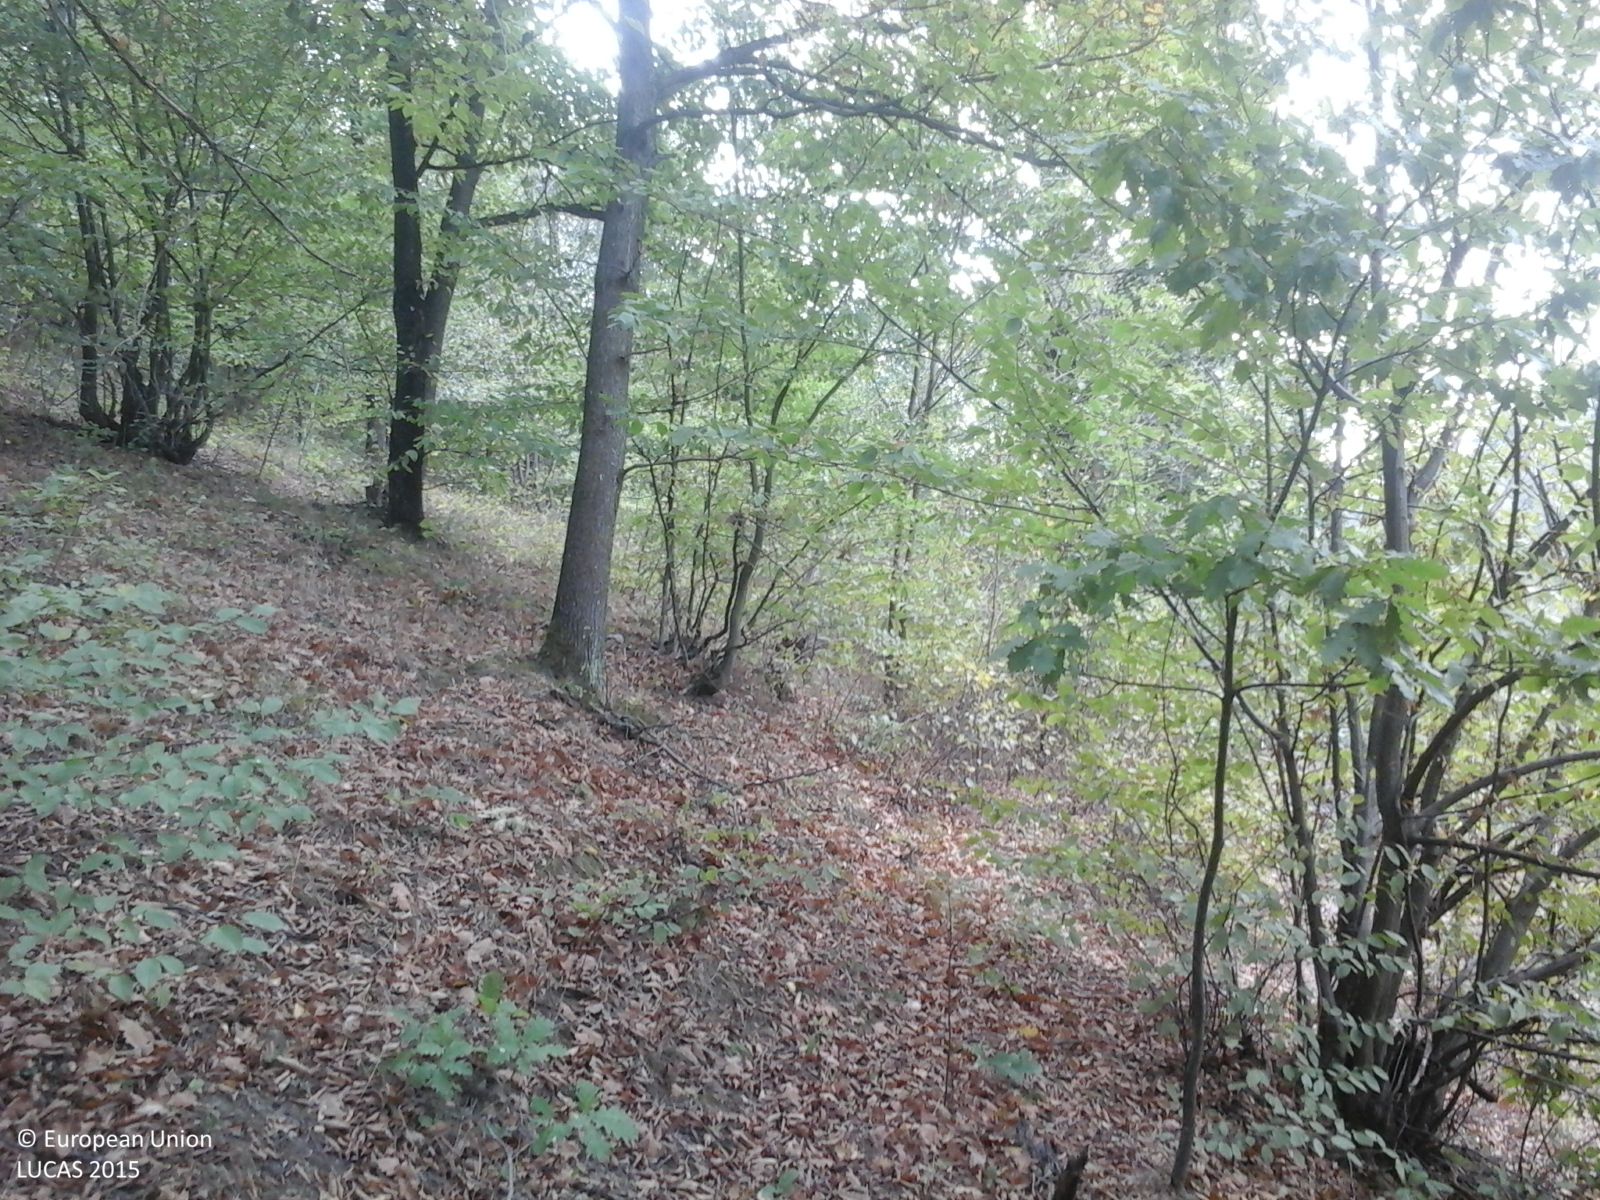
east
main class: Woodland
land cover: Broadleaved woodland
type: acidophilous oak and oak-birch forest
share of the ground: > 75 %
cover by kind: broadleaved forest trees 100 %
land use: Forestry
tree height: > 5 m
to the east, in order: Broadleaved woodland; Grassland with sparse tree/shrub cover
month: September
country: RO
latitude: 45.3873
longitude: 22.1090
